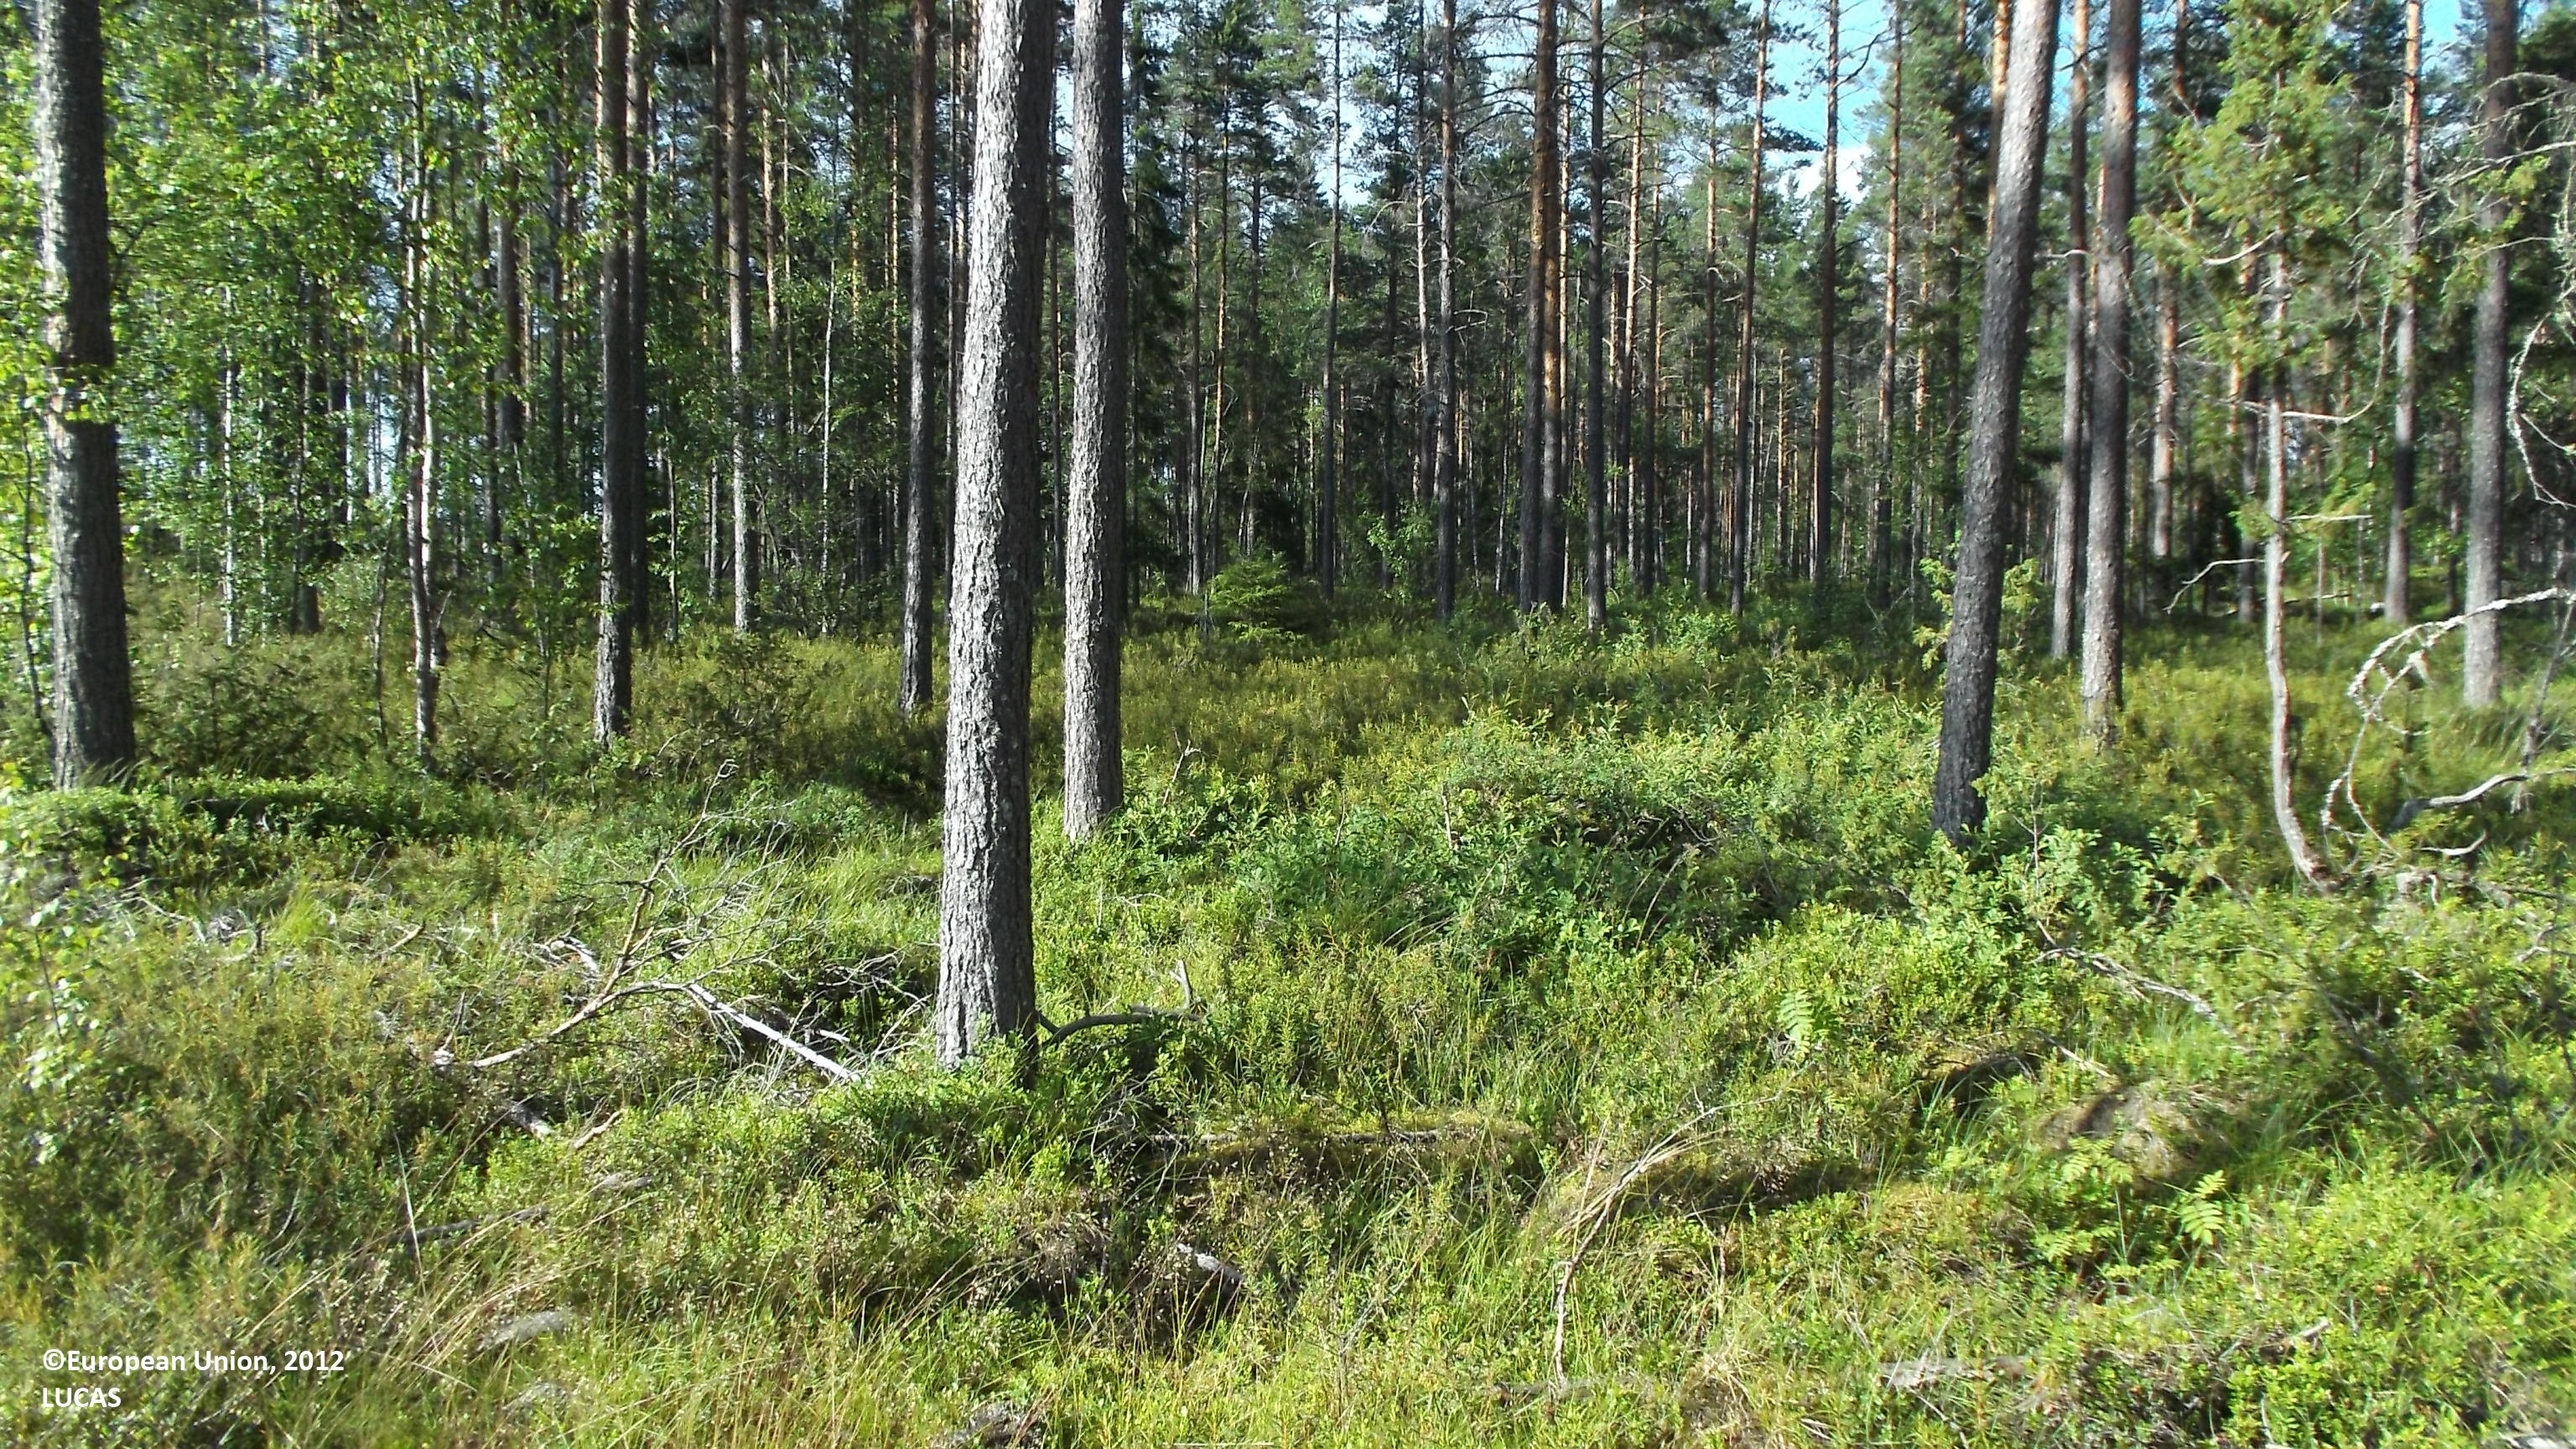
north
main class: Woodland
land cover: Pine dominated coniferous woodland
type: boreal forest
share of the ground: 25 - 50 %
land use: Forestry
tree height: > 5 m
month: July
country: FI
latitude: 63.7172
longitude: 23.8090
